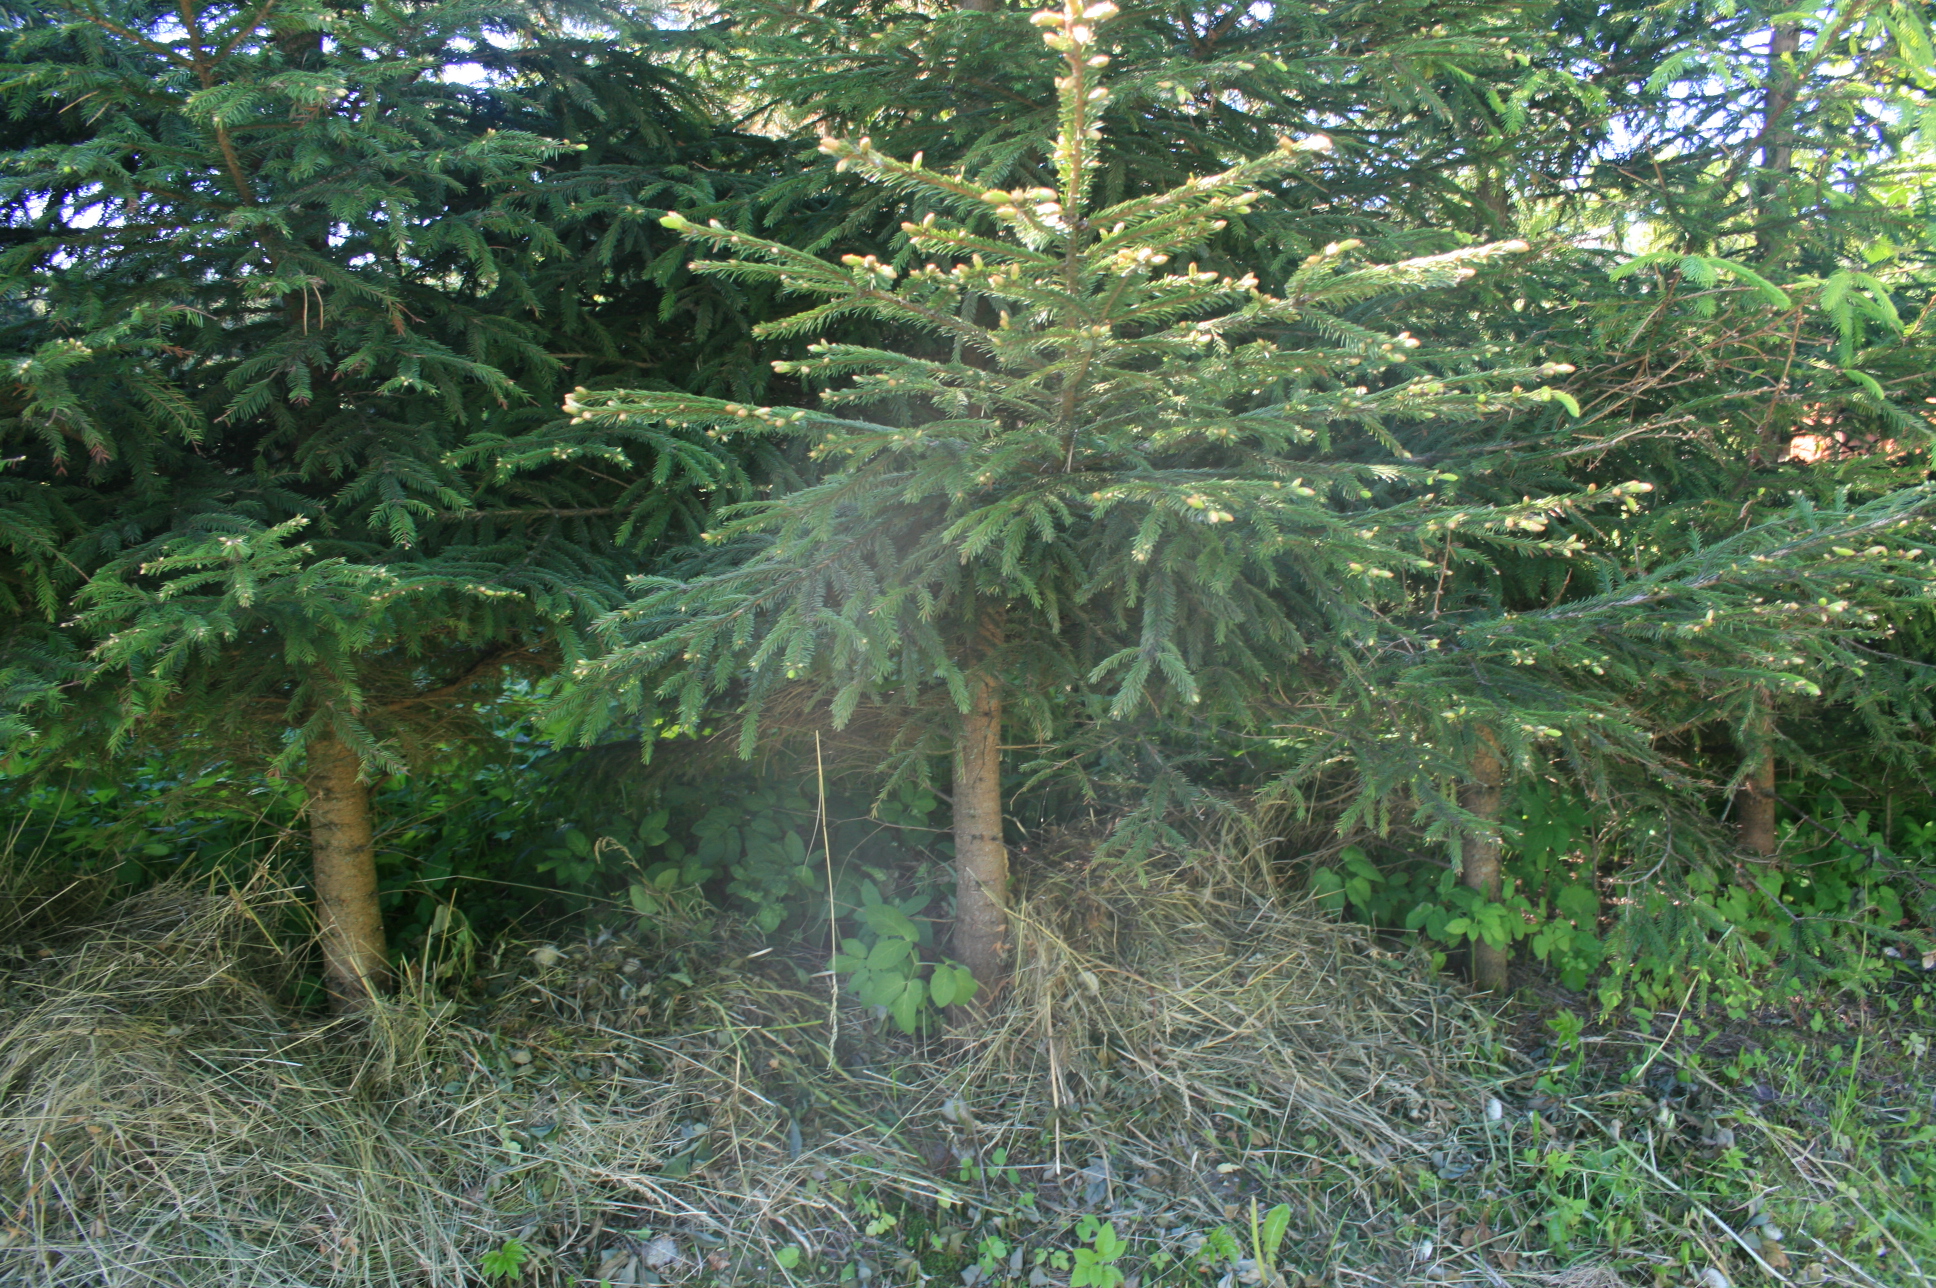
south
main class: Grassland
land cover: Grassland without tree/shrub cover
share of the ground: > 75 %
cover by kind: herbaceous plants 100 %
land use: Road transport
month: June
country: LT
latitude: 55.9217
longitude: 21.5183
